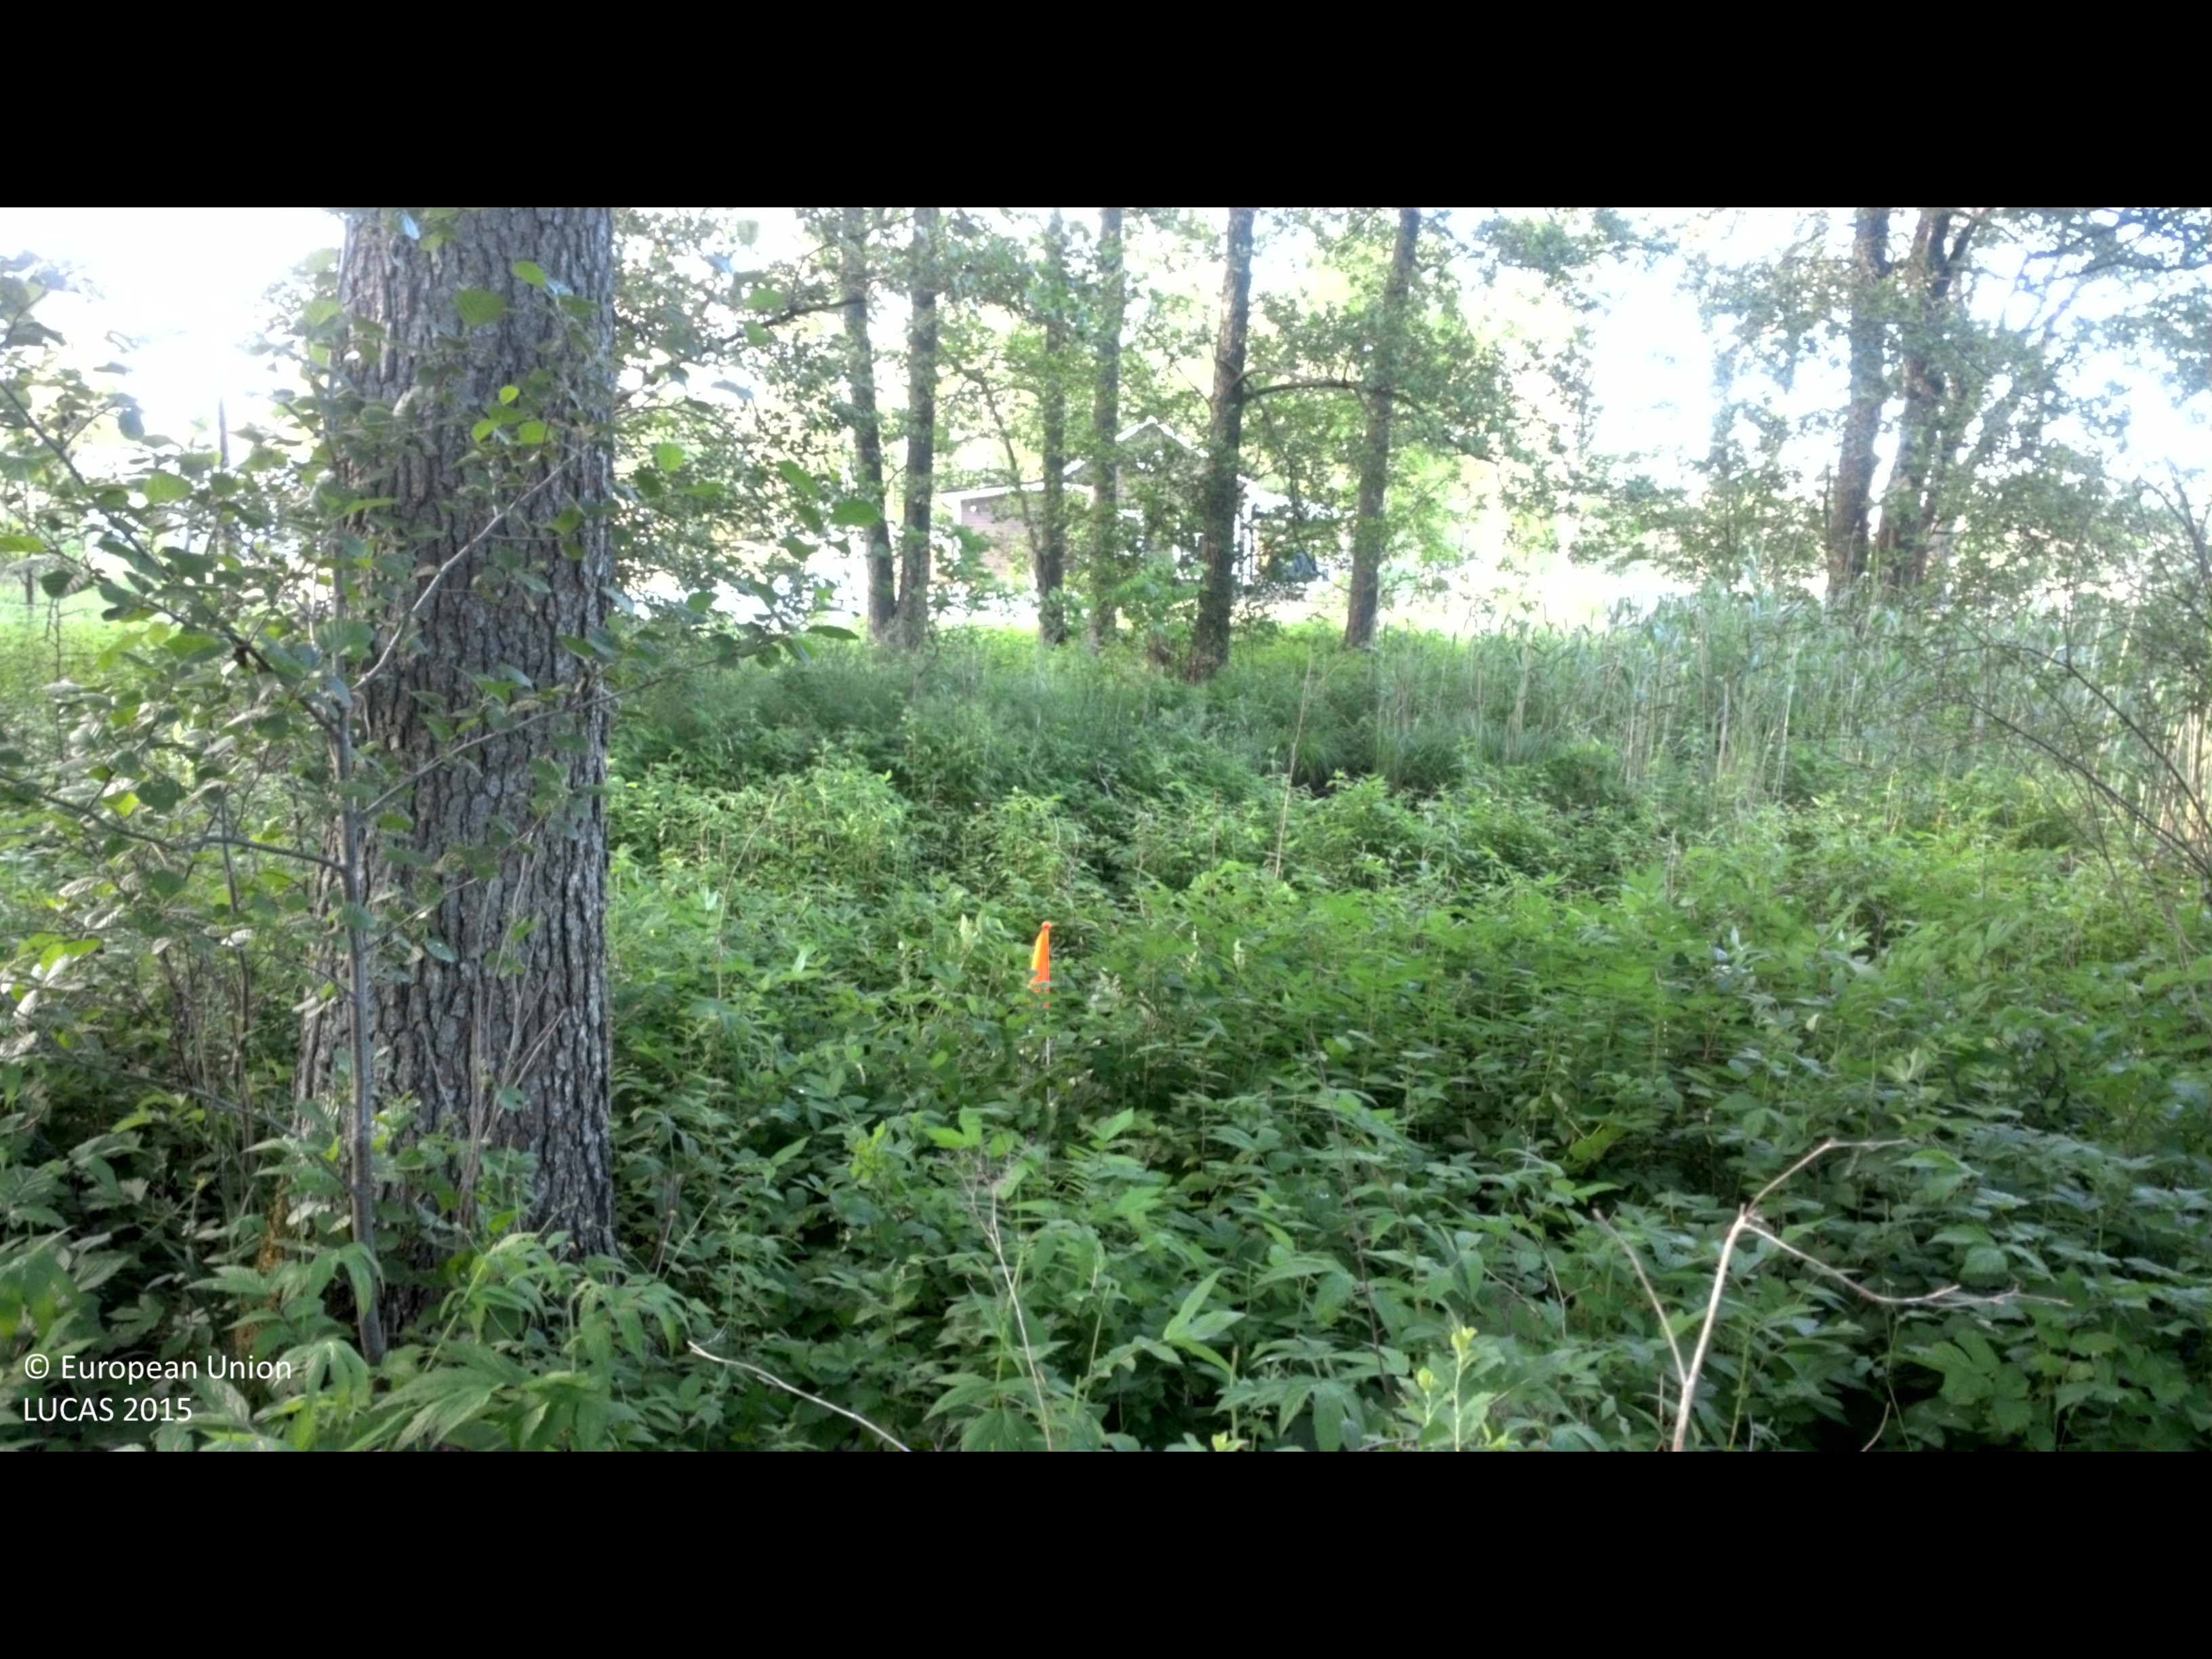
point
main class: Woodland
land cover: Broadleaved woodland
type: hemiboreal forest and nemoral coniferous forest and mixed broadleaved-coniferous forest
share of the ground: > 75 %
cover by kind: broadleaved forest trees 75 %, herbaceous plants 20 %, shrubs 5 %
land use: Forestry
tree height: > 5 m
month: June
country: SE
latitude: 57.7649
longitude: 16.6722
